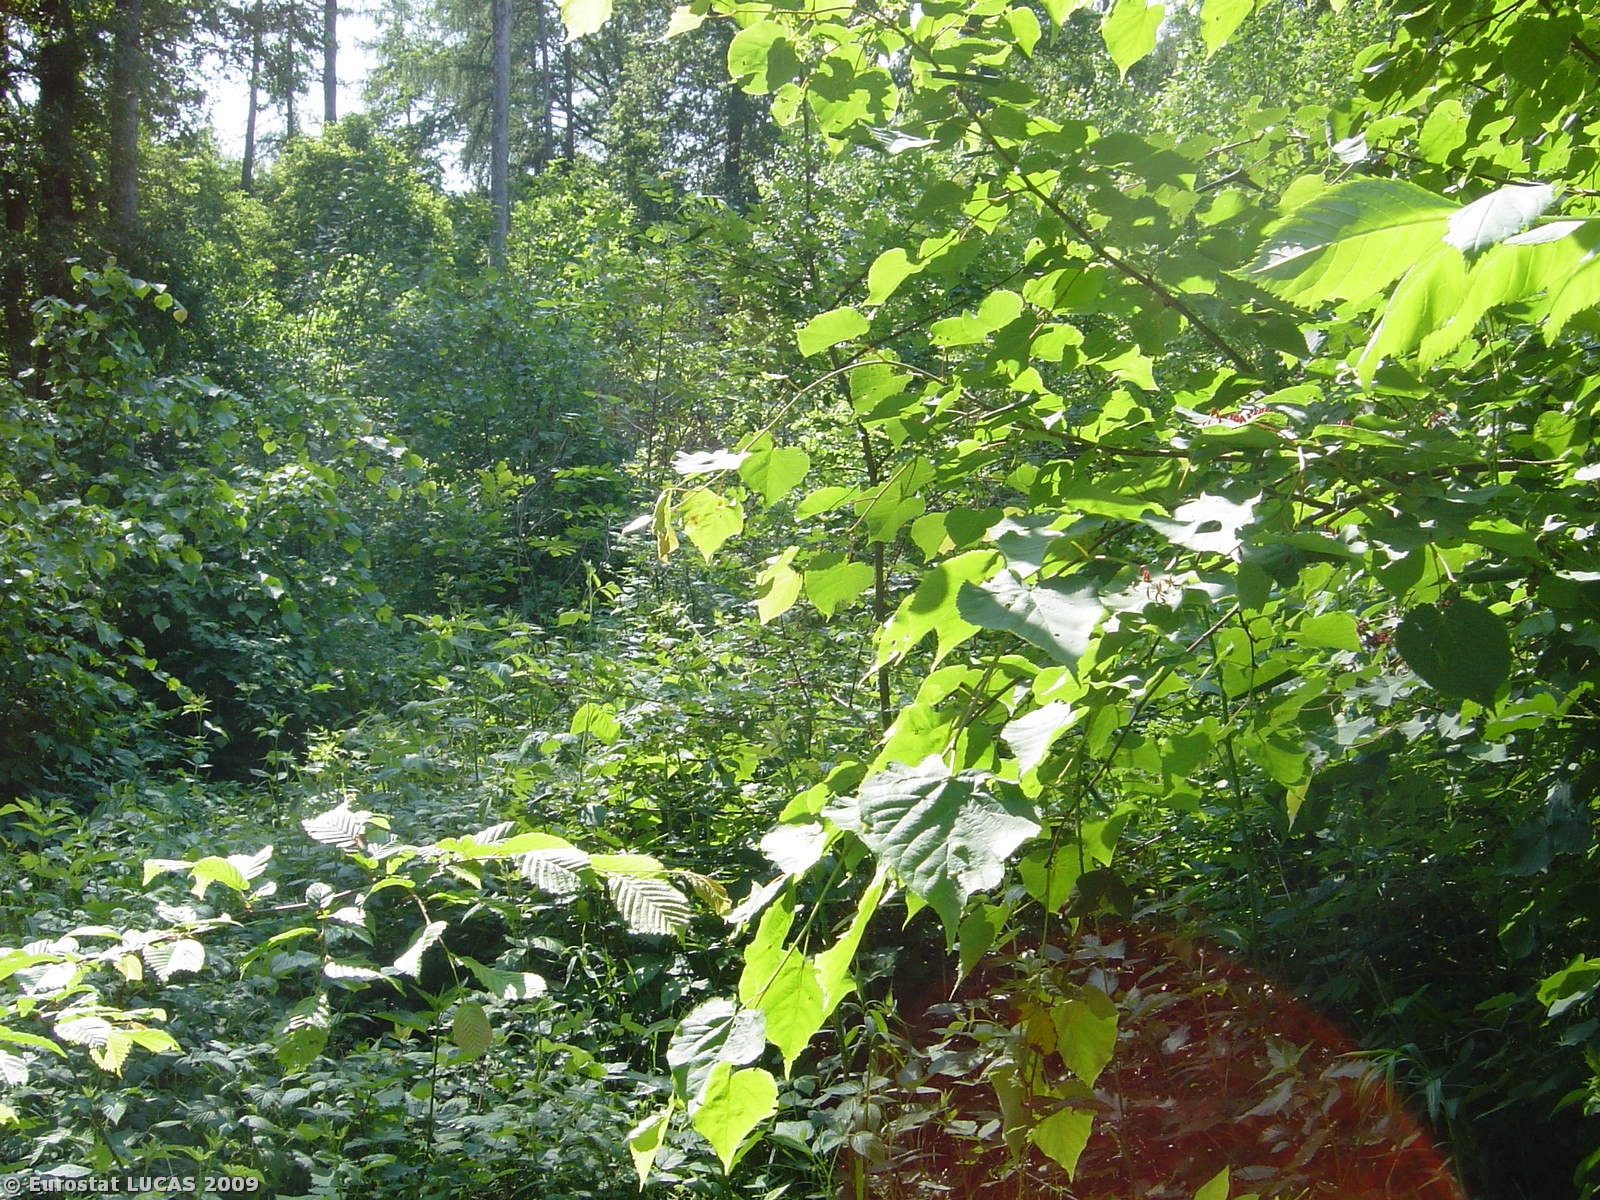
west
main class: Woodland
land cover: Broadleaved woodland
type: mesophytic deciduous forest
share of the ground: > 75 %
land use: Forestry
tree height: > 5 m
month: May
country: CZ
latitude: 49.0772
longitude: 17.1147
